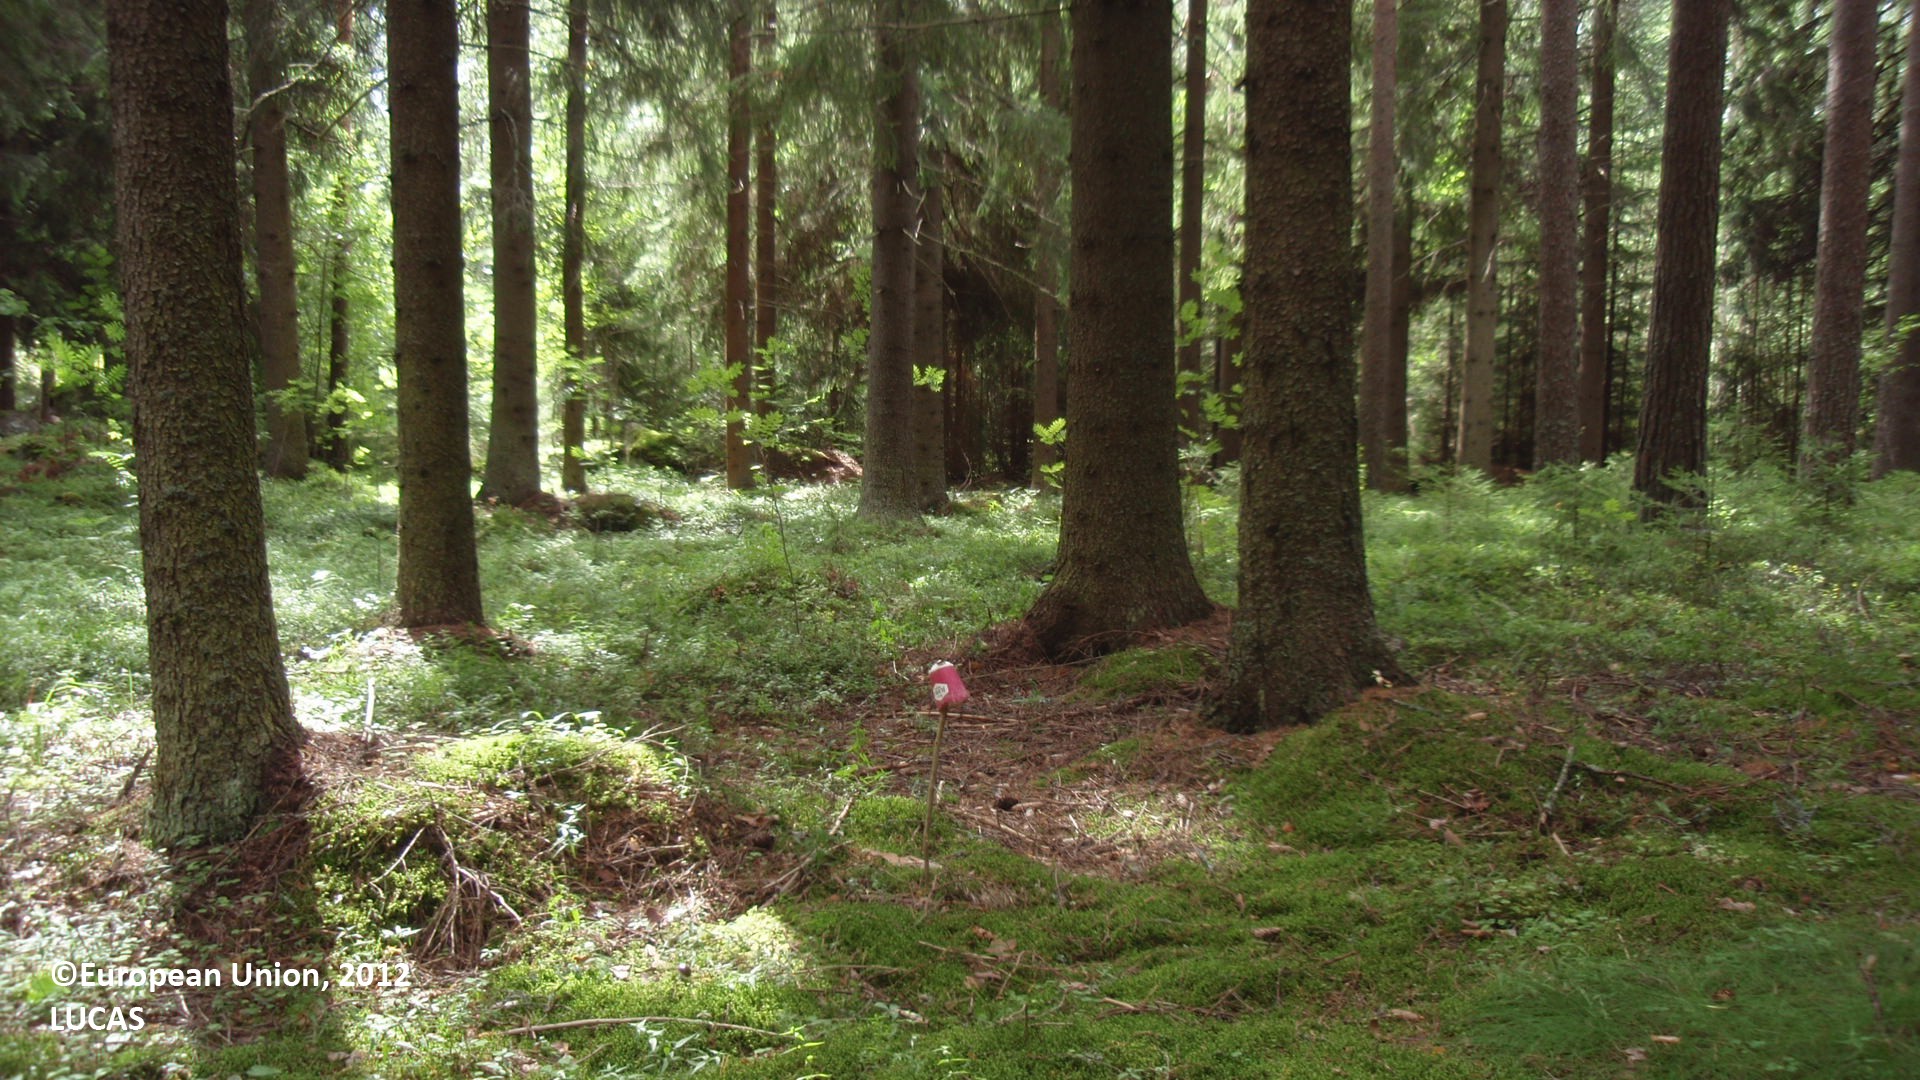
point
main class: Woodland
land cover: Spruce dominated mixed woodland
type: boreal forest
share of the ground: 50 - 75 %
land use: Agriculture (excluding fallow land and kitchen gardens)
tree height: > 5 m
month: August
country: FI
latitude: 61.0373
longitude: 27.4908
